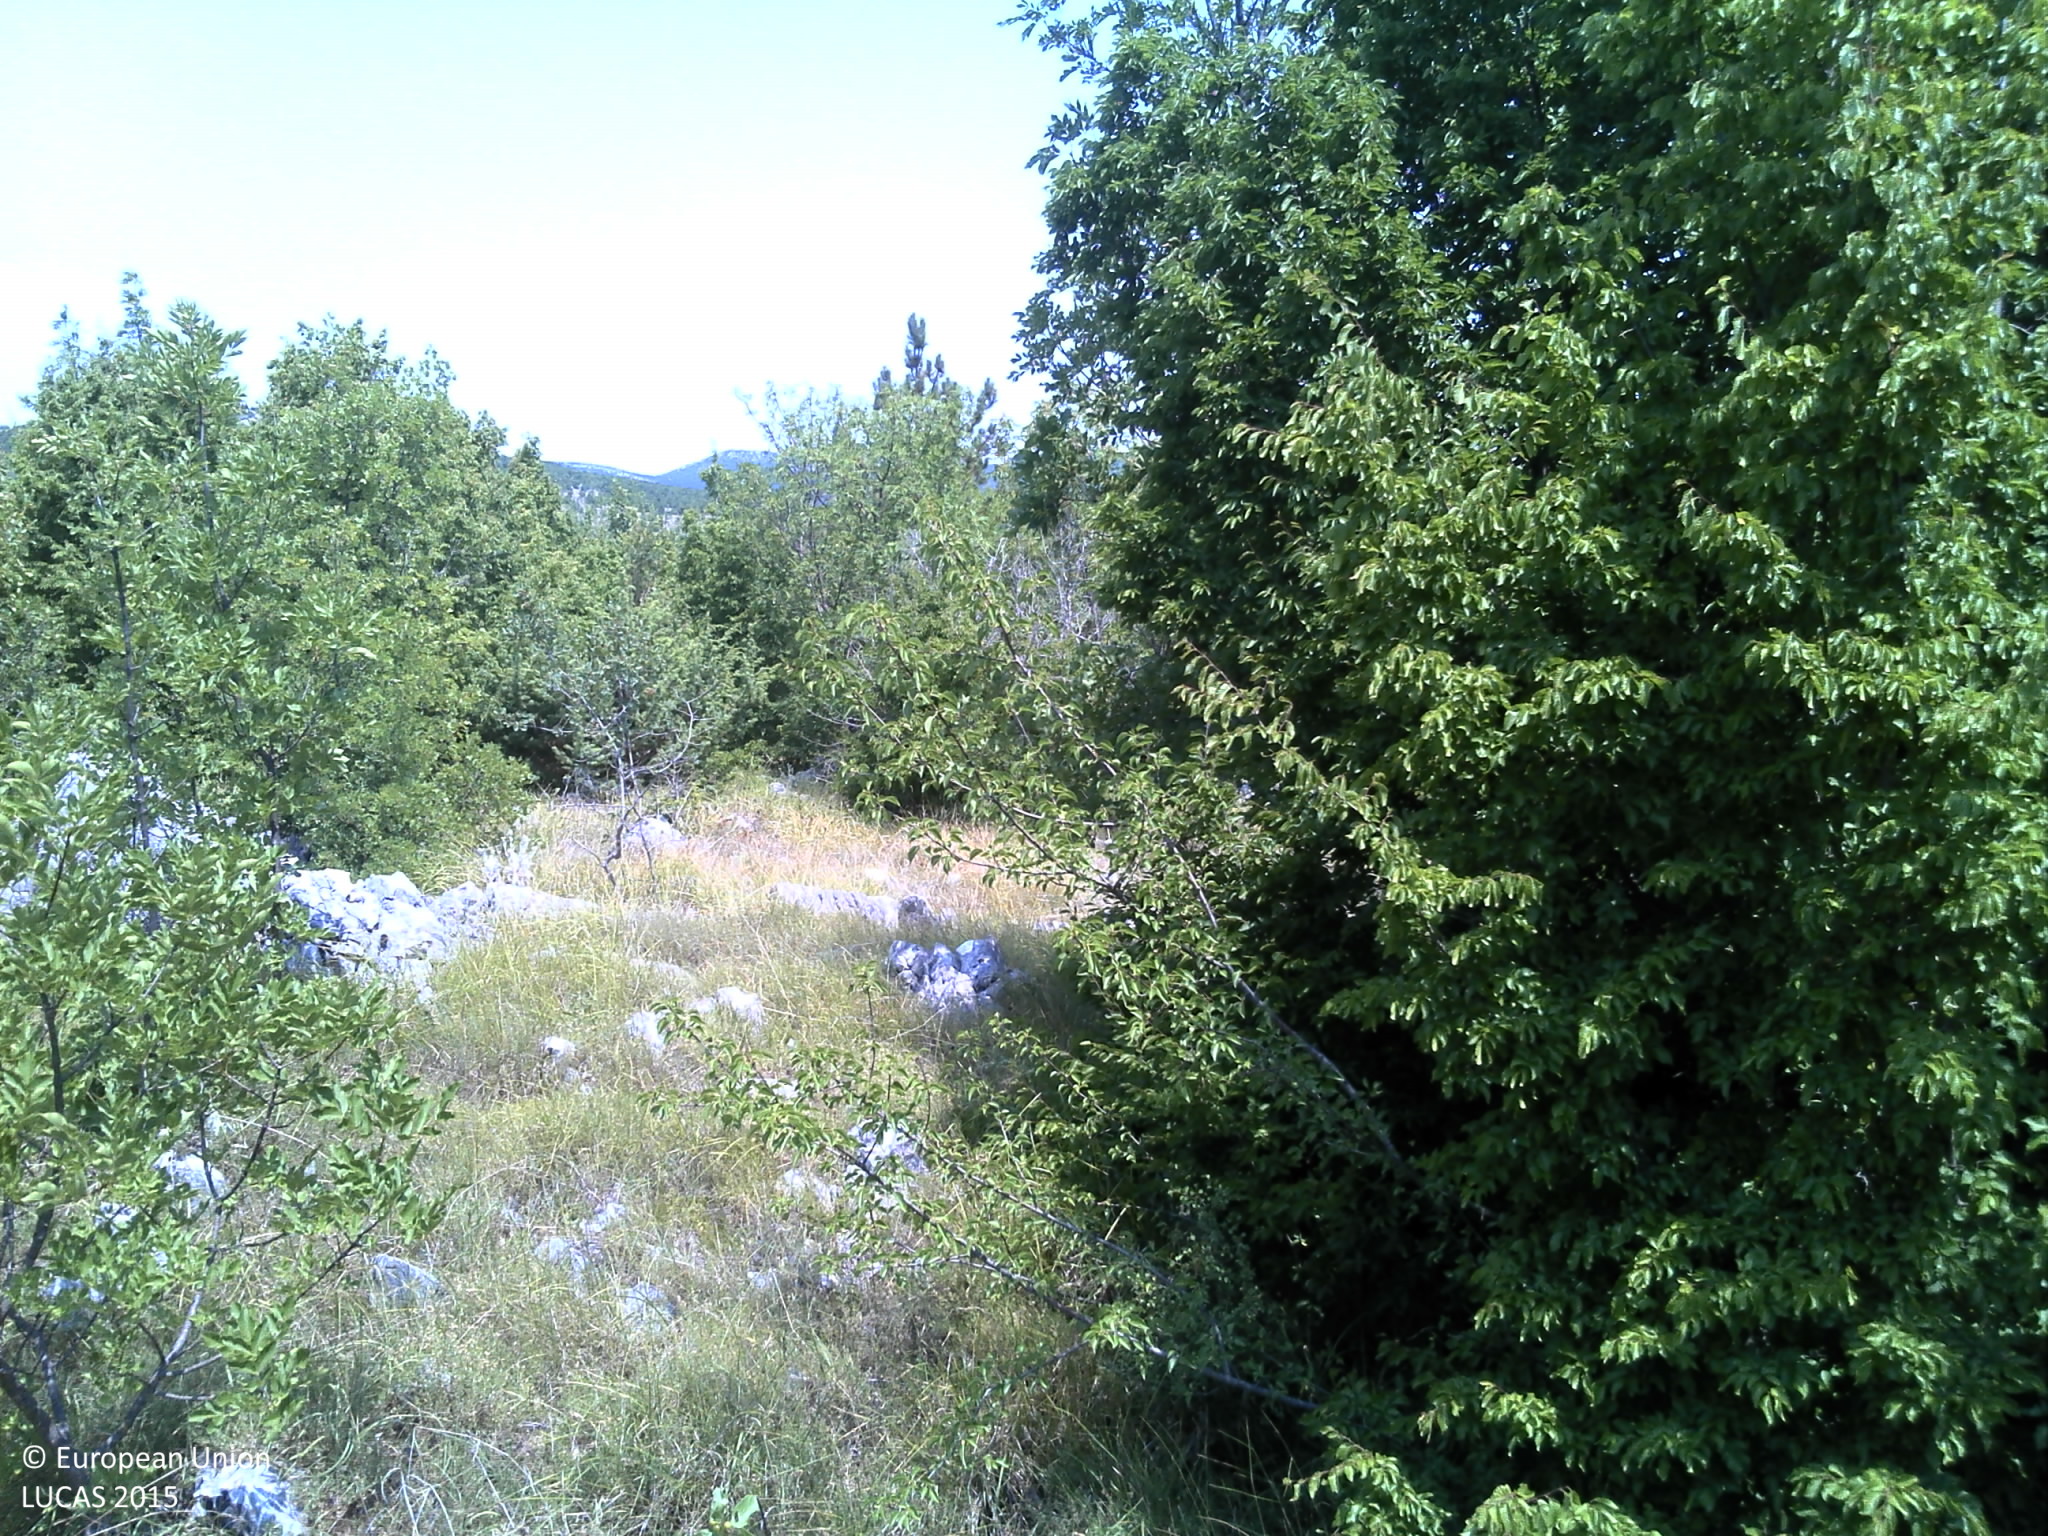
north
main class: Shrubland
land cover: Shrubland with sparse tree cover
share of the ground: > 75 %
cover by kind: shrubs 70 %, herbaceous plants 10 %, unconsolidated bare surface 10 %, broadleaved forest trees 5 %, consolidated bare surface 5 %
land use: Semi-natural and natural areas not in use
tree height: > 5 m
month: July
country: HR
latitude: 43.5196
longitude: 16.9568
